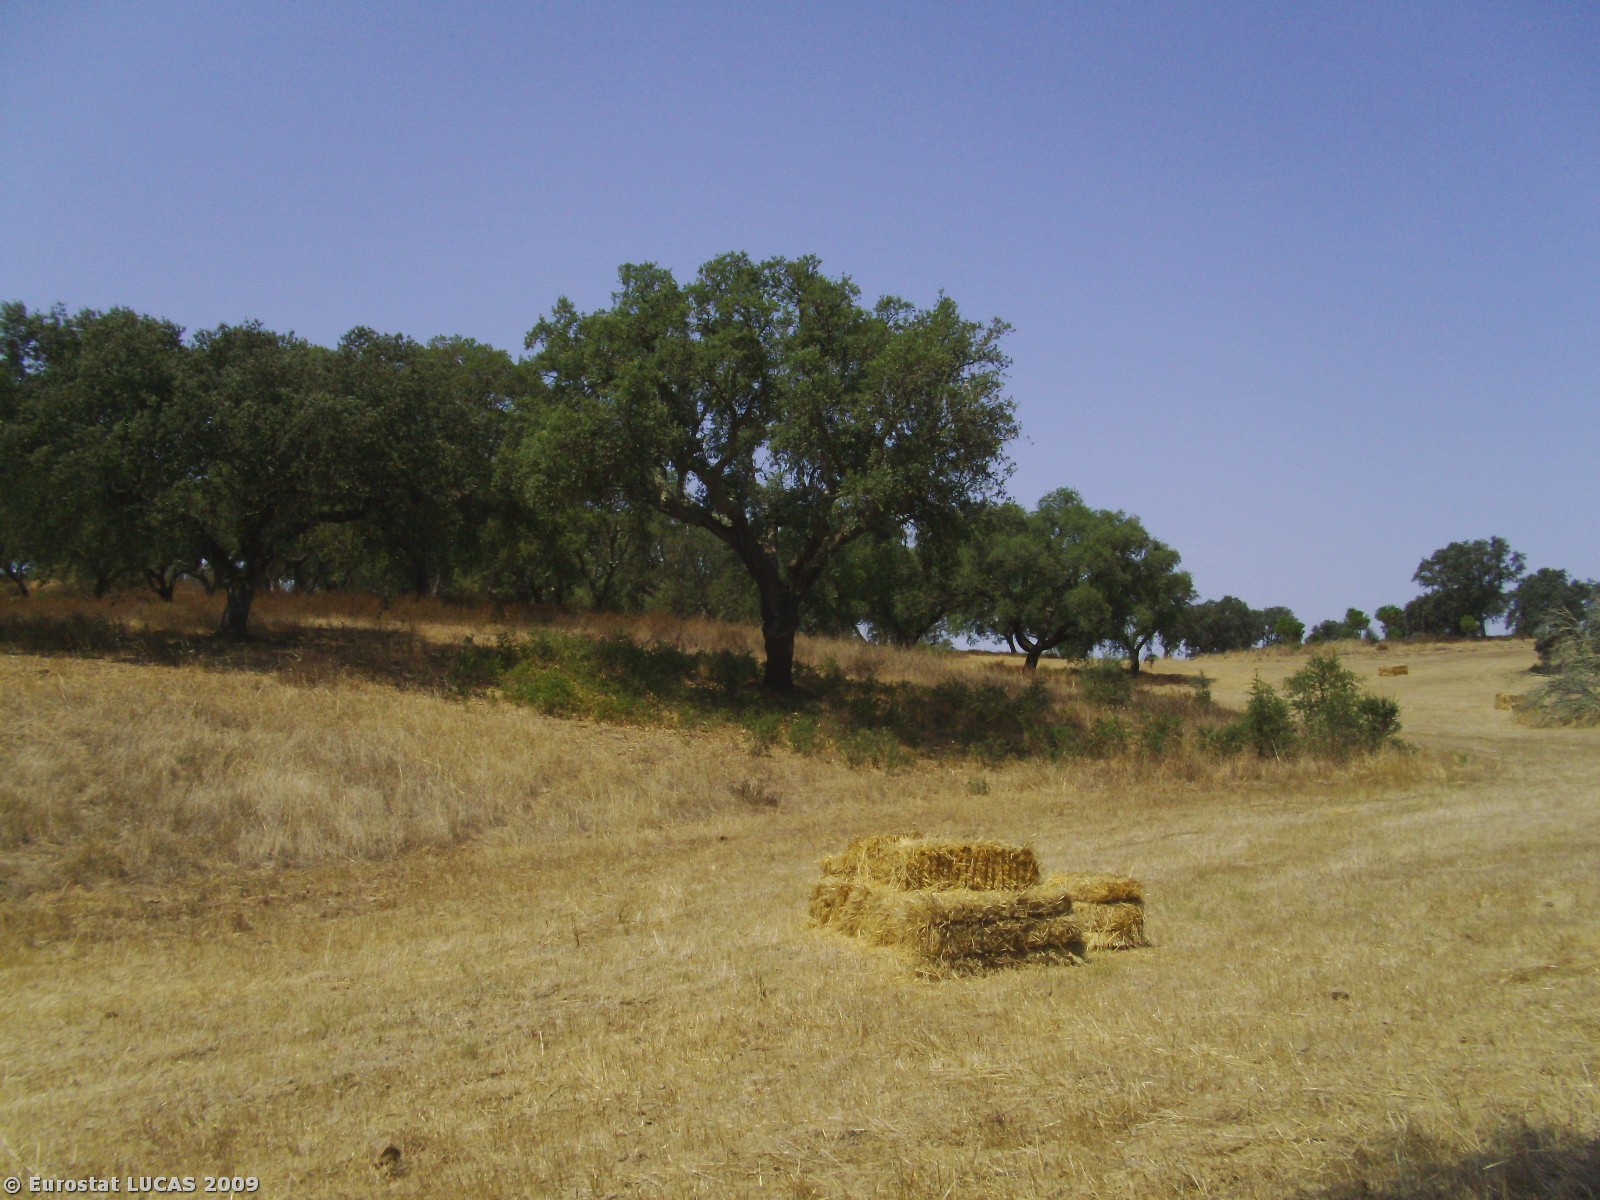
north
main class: Woodland
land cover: Broadleaved woodland
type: broadleaved evergreen forest
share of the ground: 50 - 75 %
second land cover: Oats
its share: < 10 %
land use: Forestry
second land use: Agriculture (excluding fallow land and kitchen gardens)
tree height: > 5 m
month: August
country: PT
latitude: 38.3864
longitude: -7.7896
